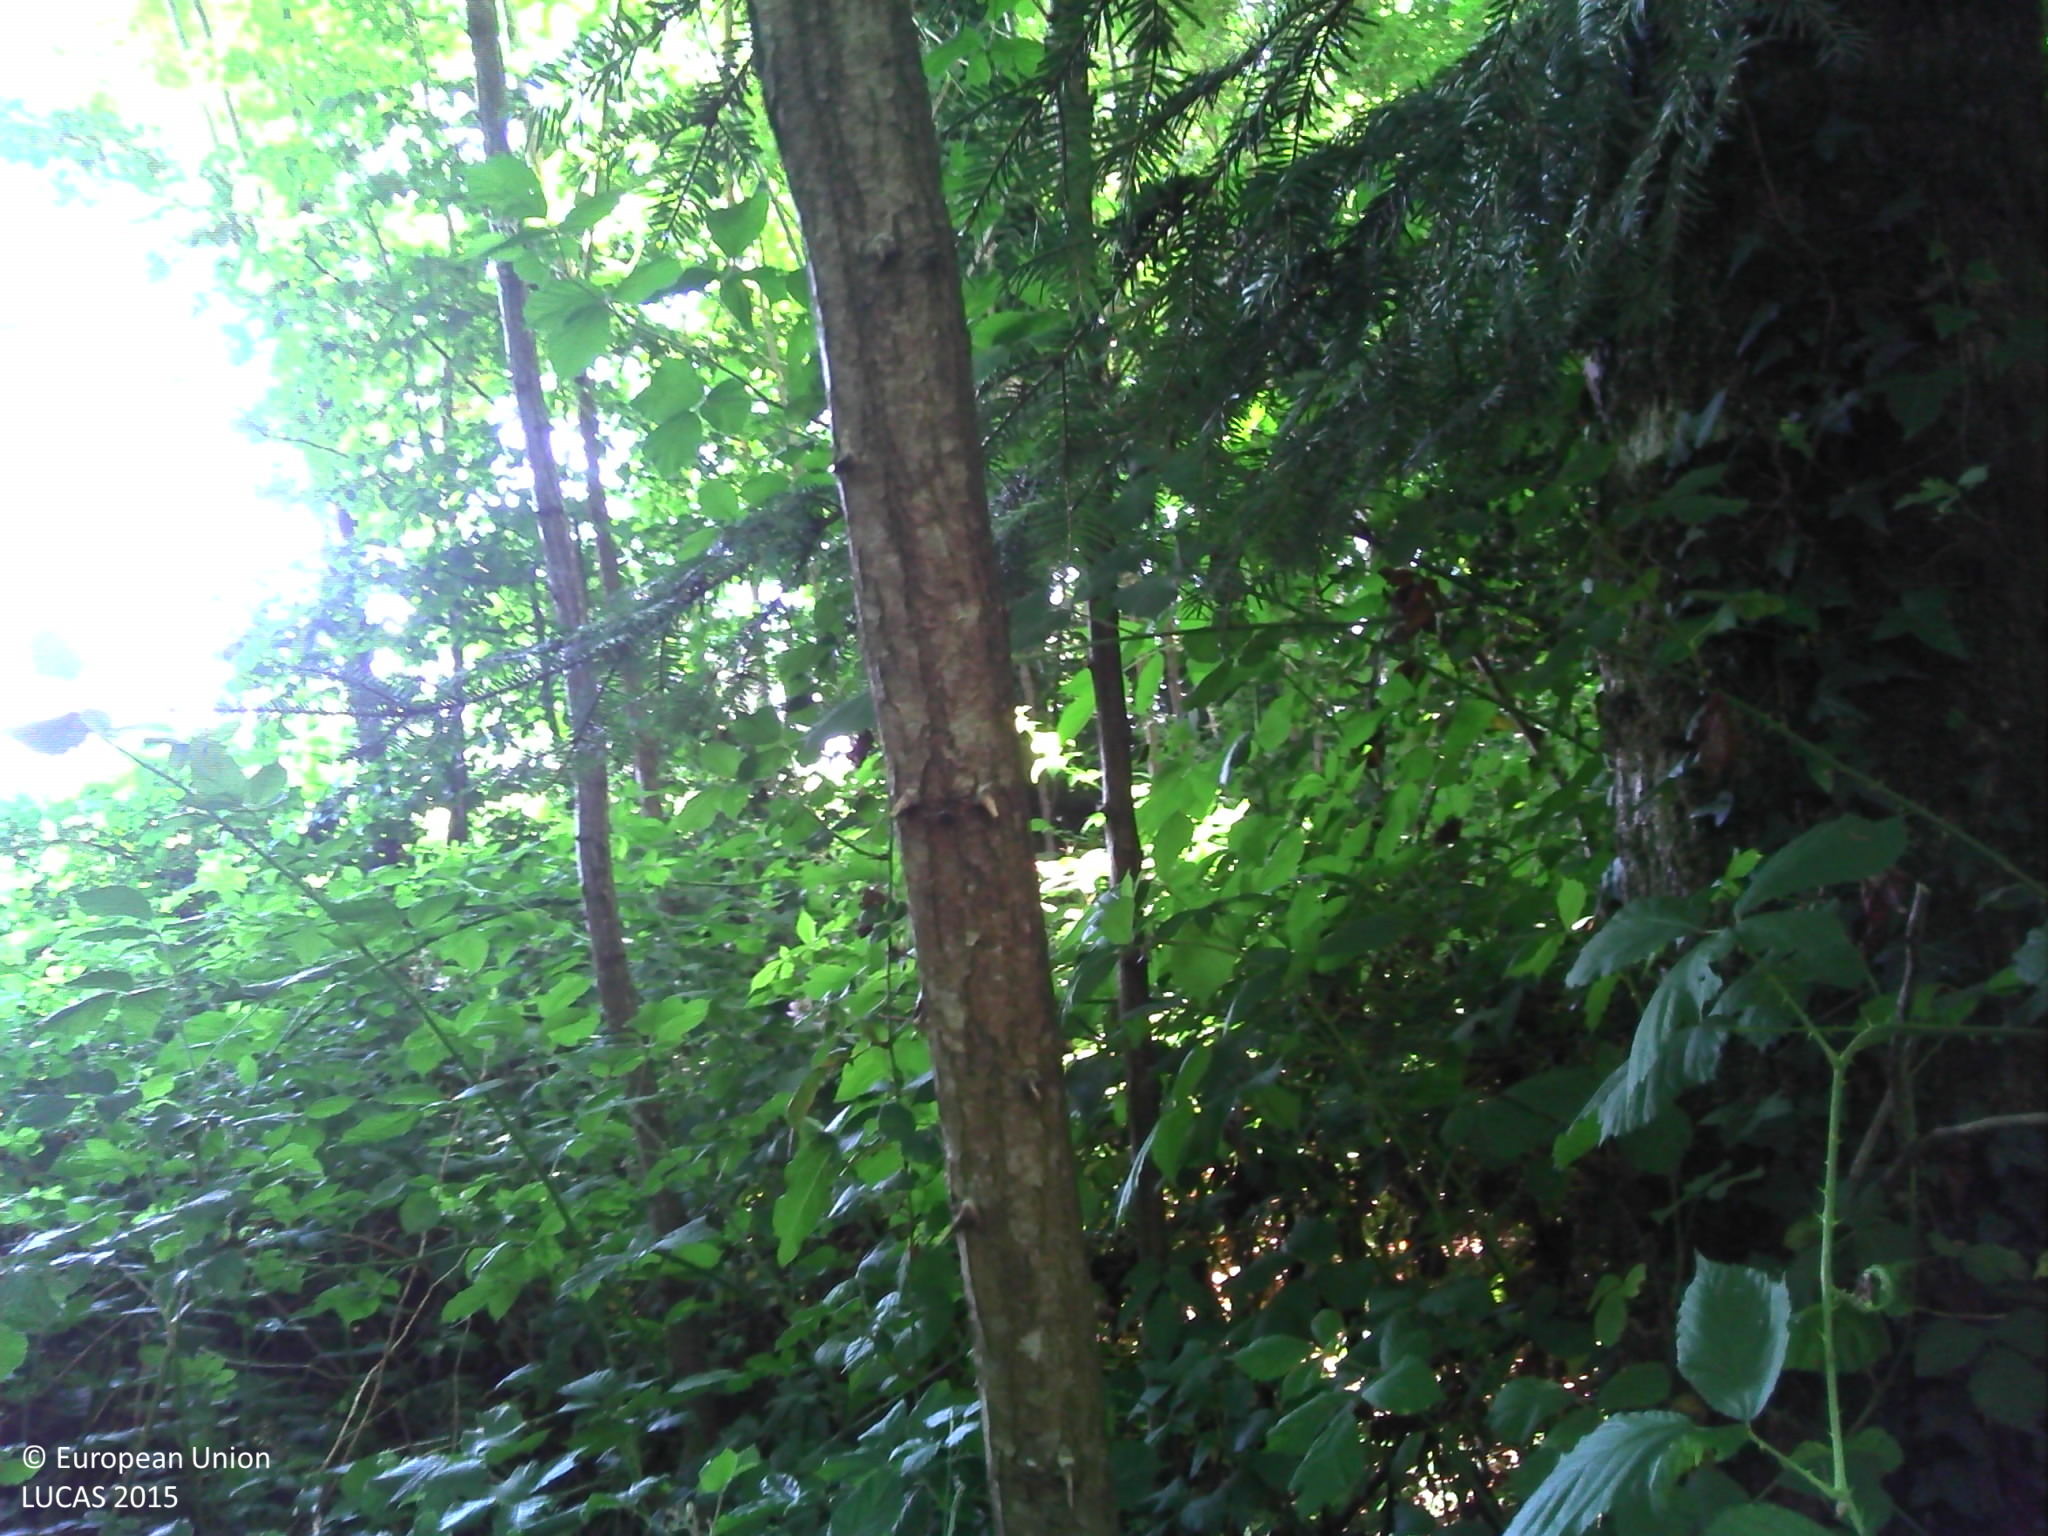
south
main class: Woodland
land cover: Other mixed woodland
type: mesophytic deciduous forest
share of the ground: > 75 %
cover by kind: broadleaved forest trees 75 %, coniferous forest trees 25 %
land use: Semi-natural and natural areas not in use
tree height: > 5 m
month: June
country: FR
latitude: 45.8502
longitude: 0.6502
